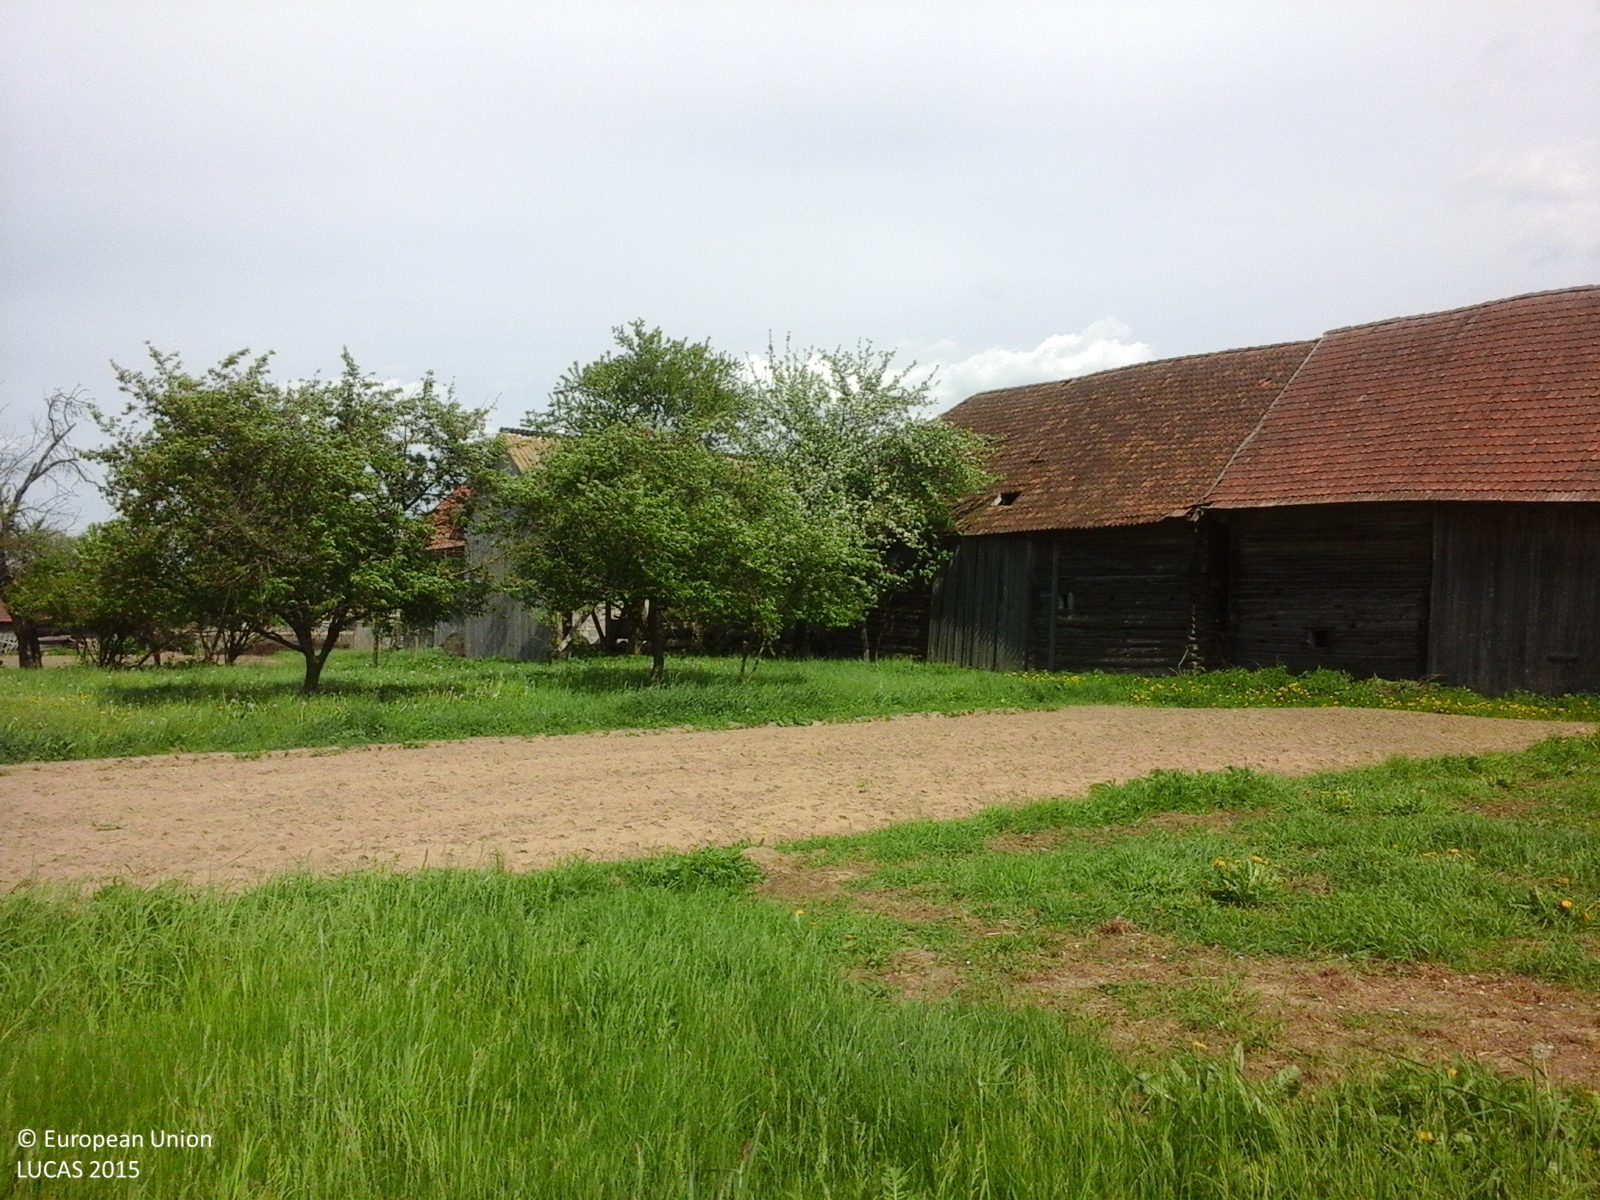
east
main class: Cropland
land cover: Other leguminous and mixtures for fodder
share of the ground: > 75 %
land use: Agriculture (excluding fallow land and kitchen gardens)
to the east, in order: Other leguminous and mixtures for fodder; Apple fruit; Artificial constructions in urban areas; Rye
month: May
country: RO
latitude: 45.8631
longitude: 26.0506
